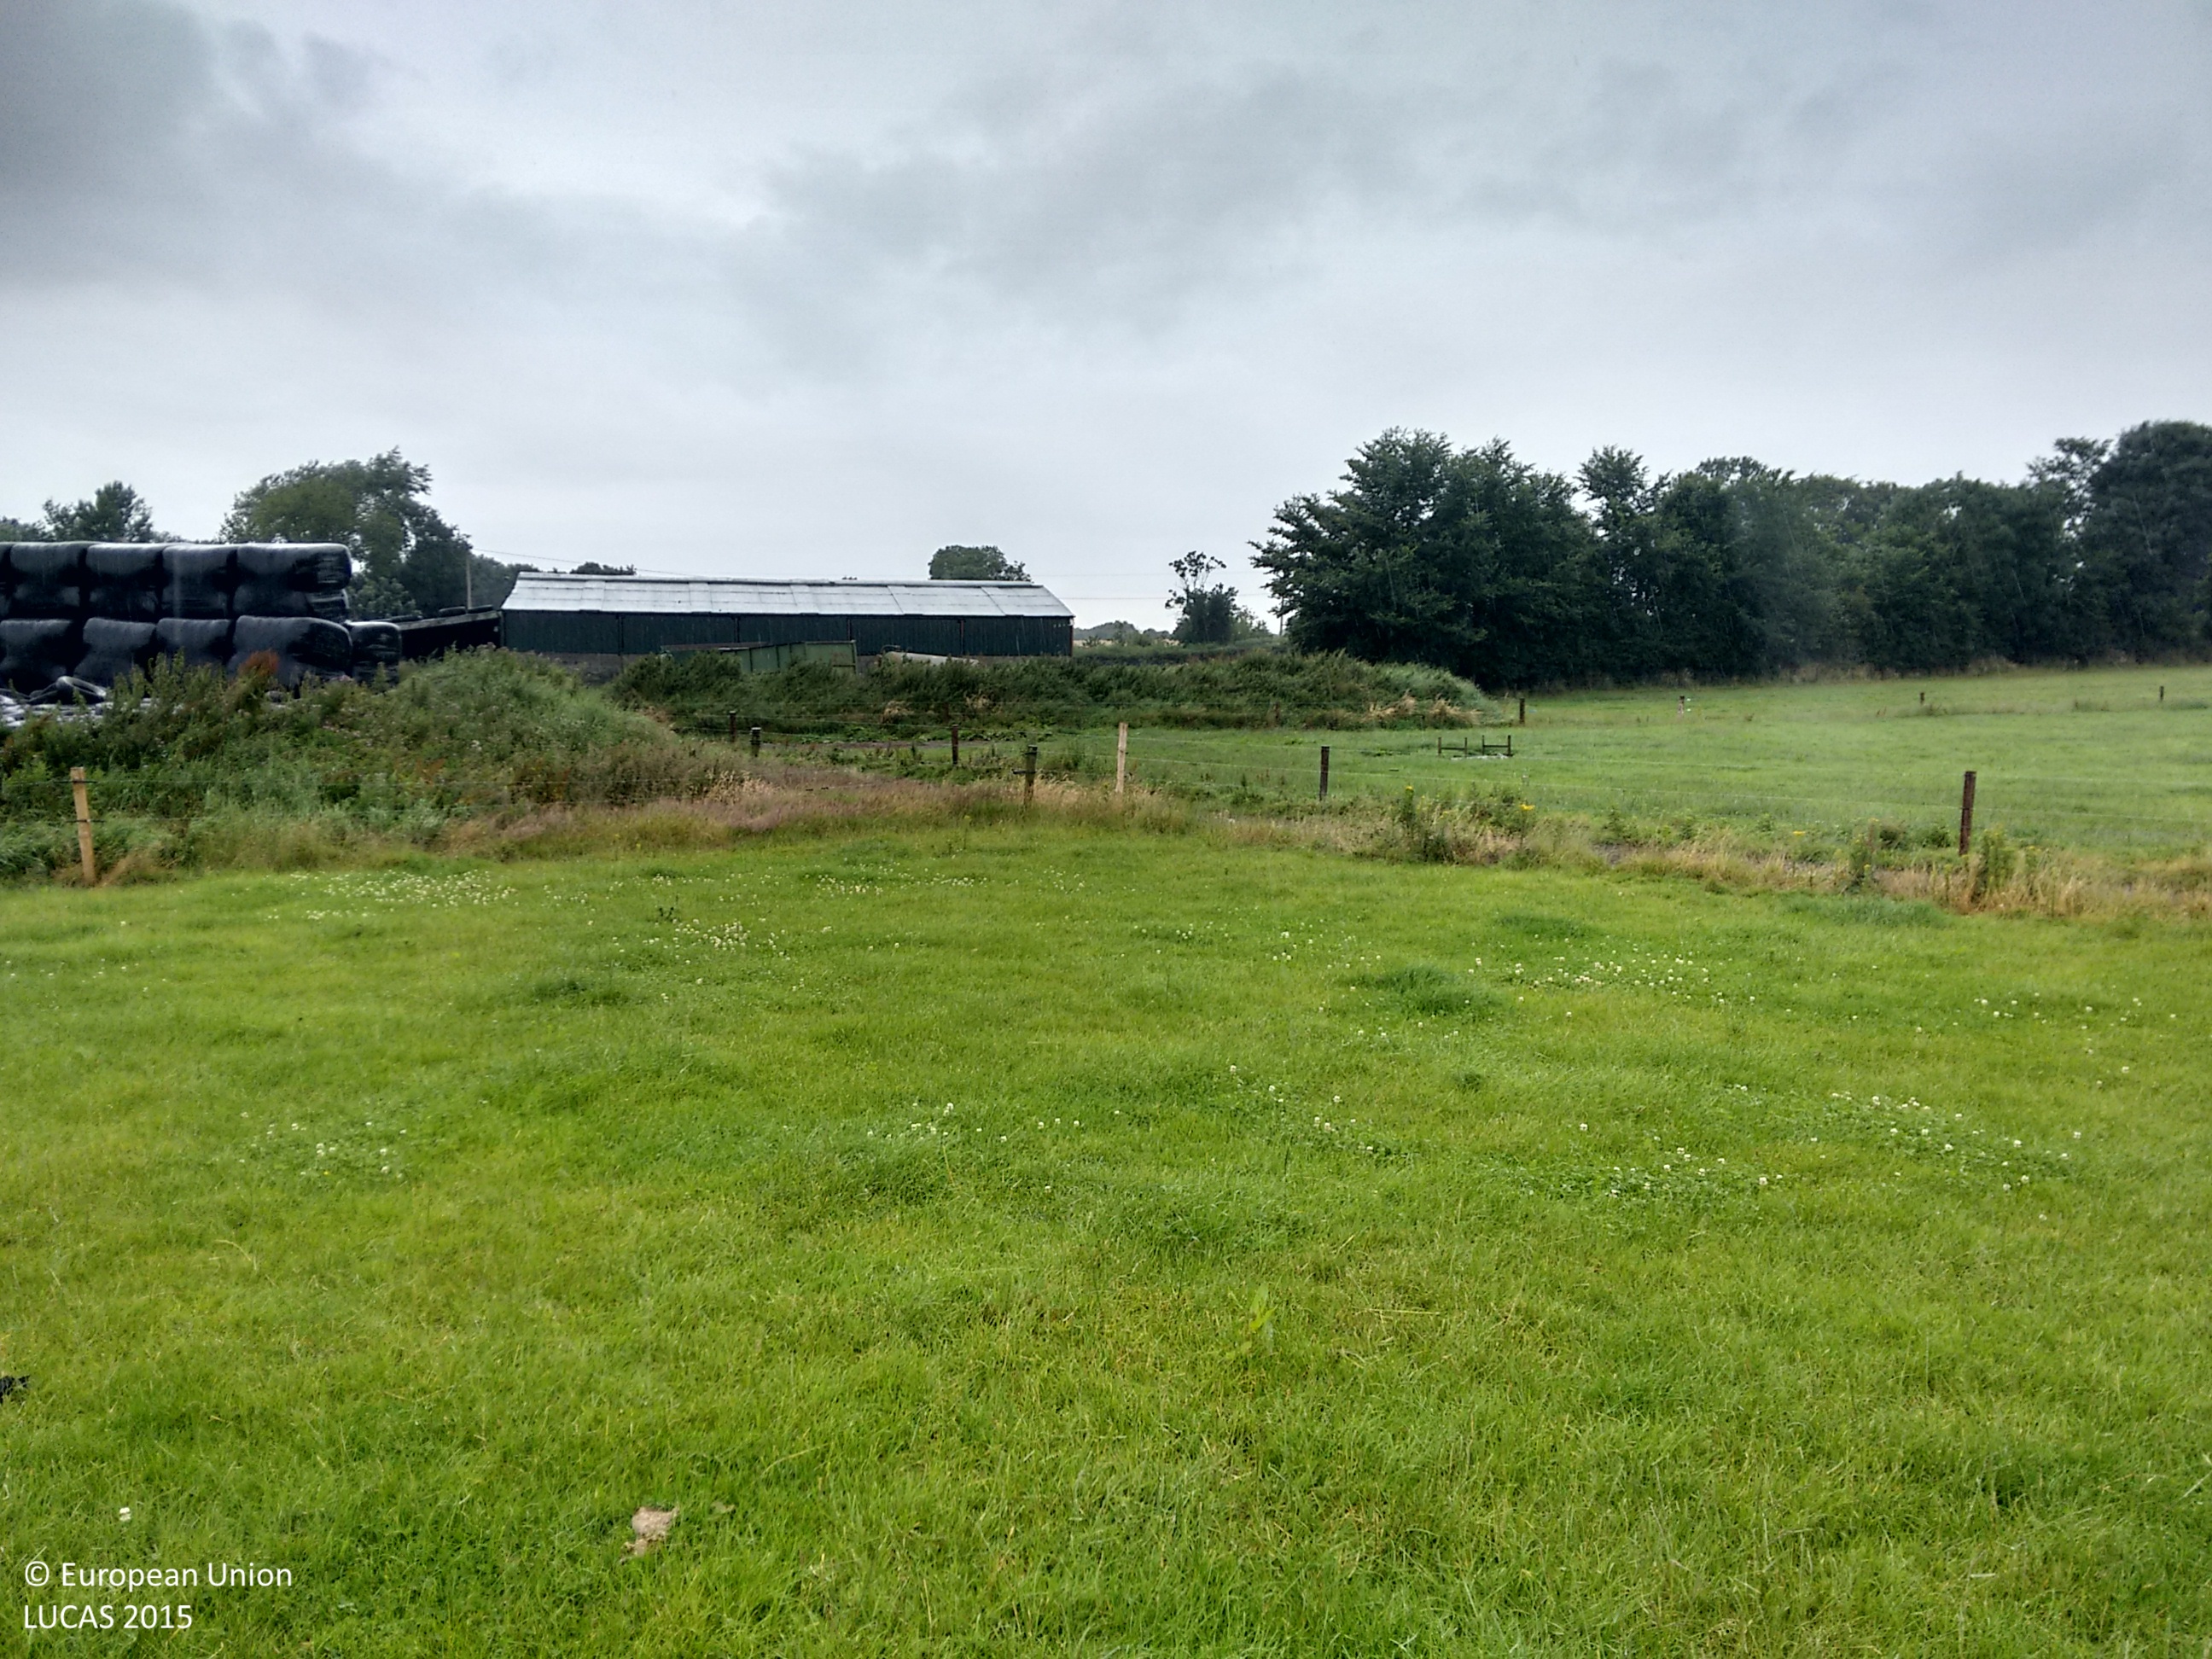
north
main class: Grassland
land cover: Grassland without tree/shrub cover
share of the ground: > 75 %
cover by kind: herbaceous plants 100 %
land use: Agriculture (excluding fallow land and kitchen gardens)
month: July
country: IE
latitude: 52.5947
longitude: -7.2304
